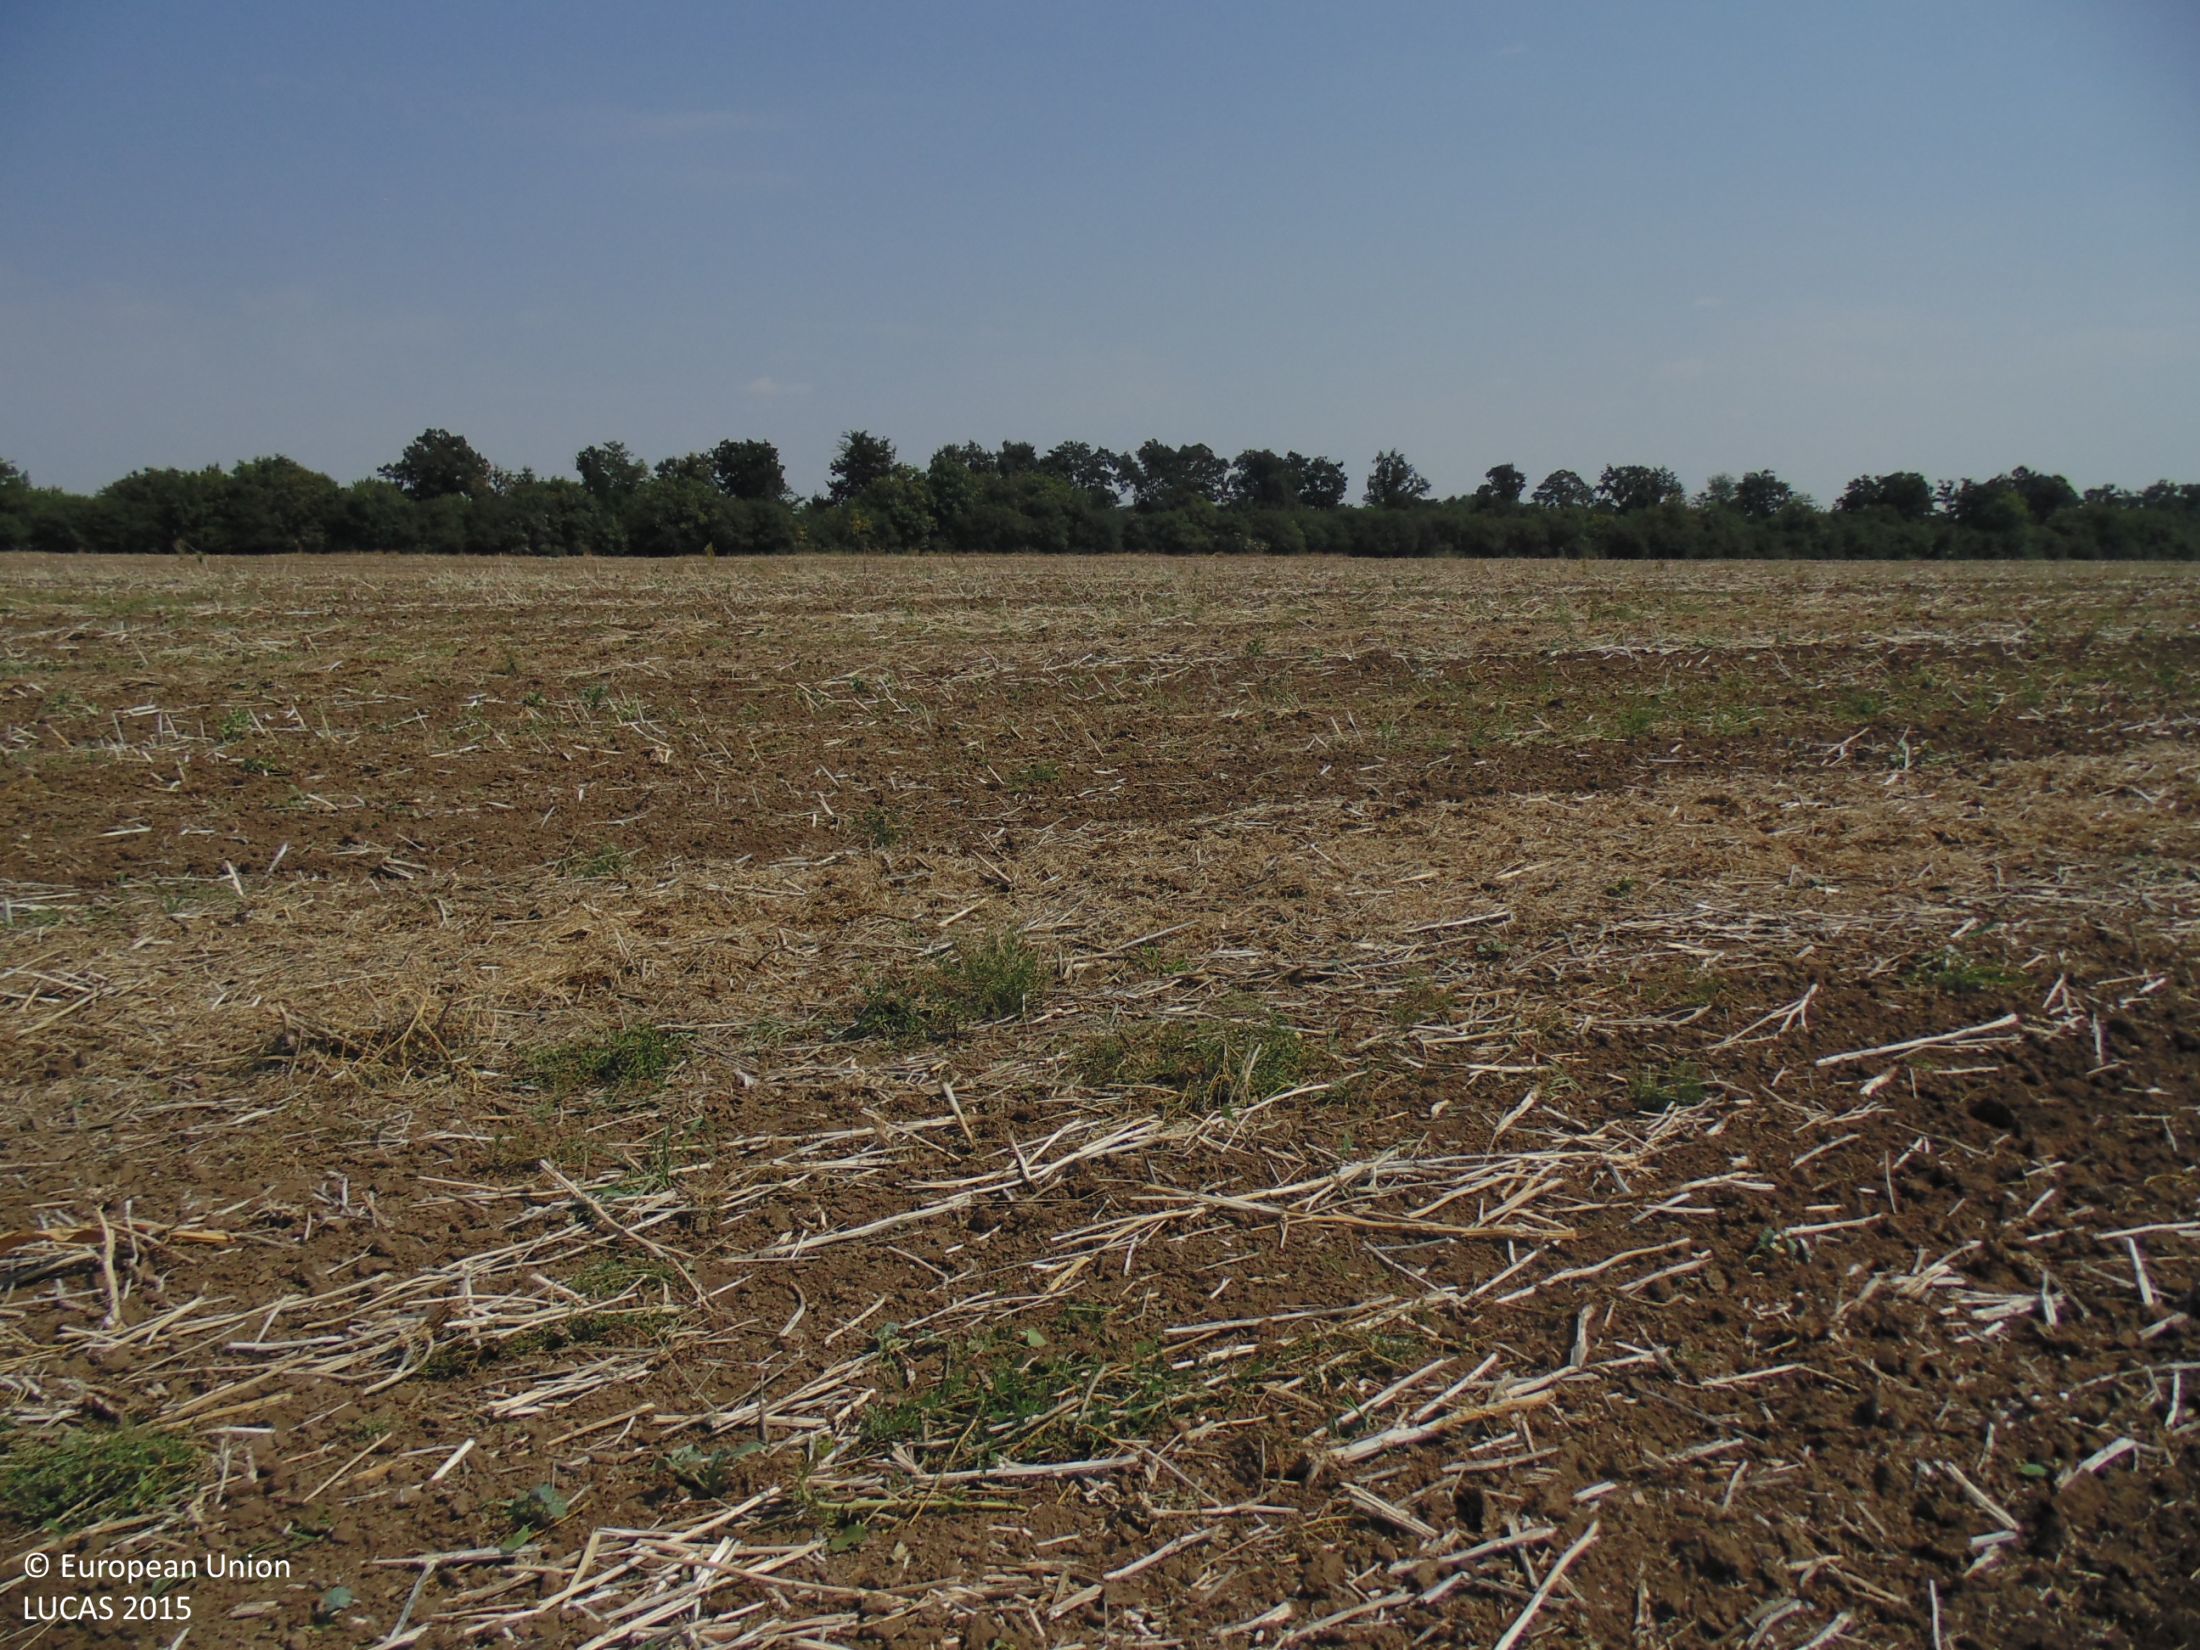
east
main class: Cropland
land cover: Rape and turnip rape
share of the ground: < 10 %
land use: Agriculture (excluding fallow land and kitchen gardens)
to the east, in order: Rape and turnip rape; Grass margins; Broadleaved woodland; Grass margins; Maize
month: August
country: BG
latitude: 43.9795
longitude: 27.2464
